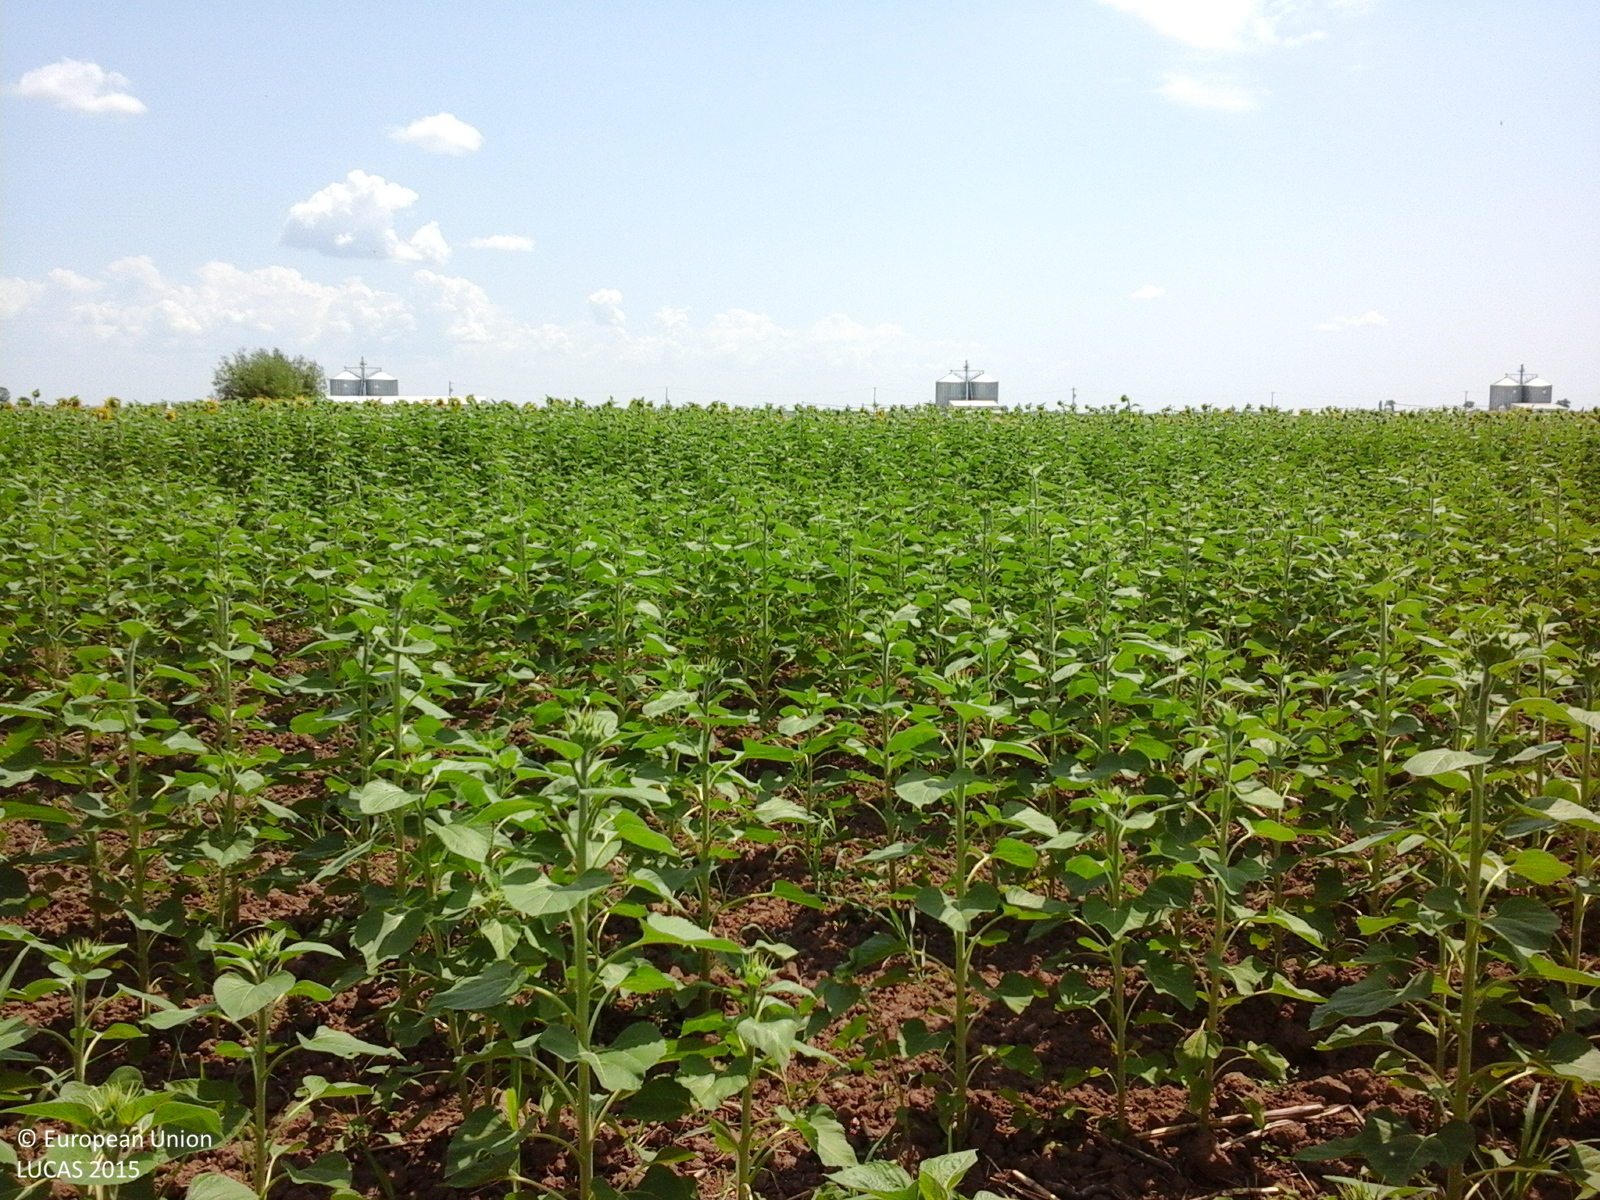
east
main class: Cropland
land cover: Sunflower
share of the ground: > 75 %
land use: Agriculture (excluding fallow land and kitchen gardens)
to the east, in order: Sunflower; Rye; Common wheat
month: June
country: RO
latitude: 44.2239
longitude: 26.3191
